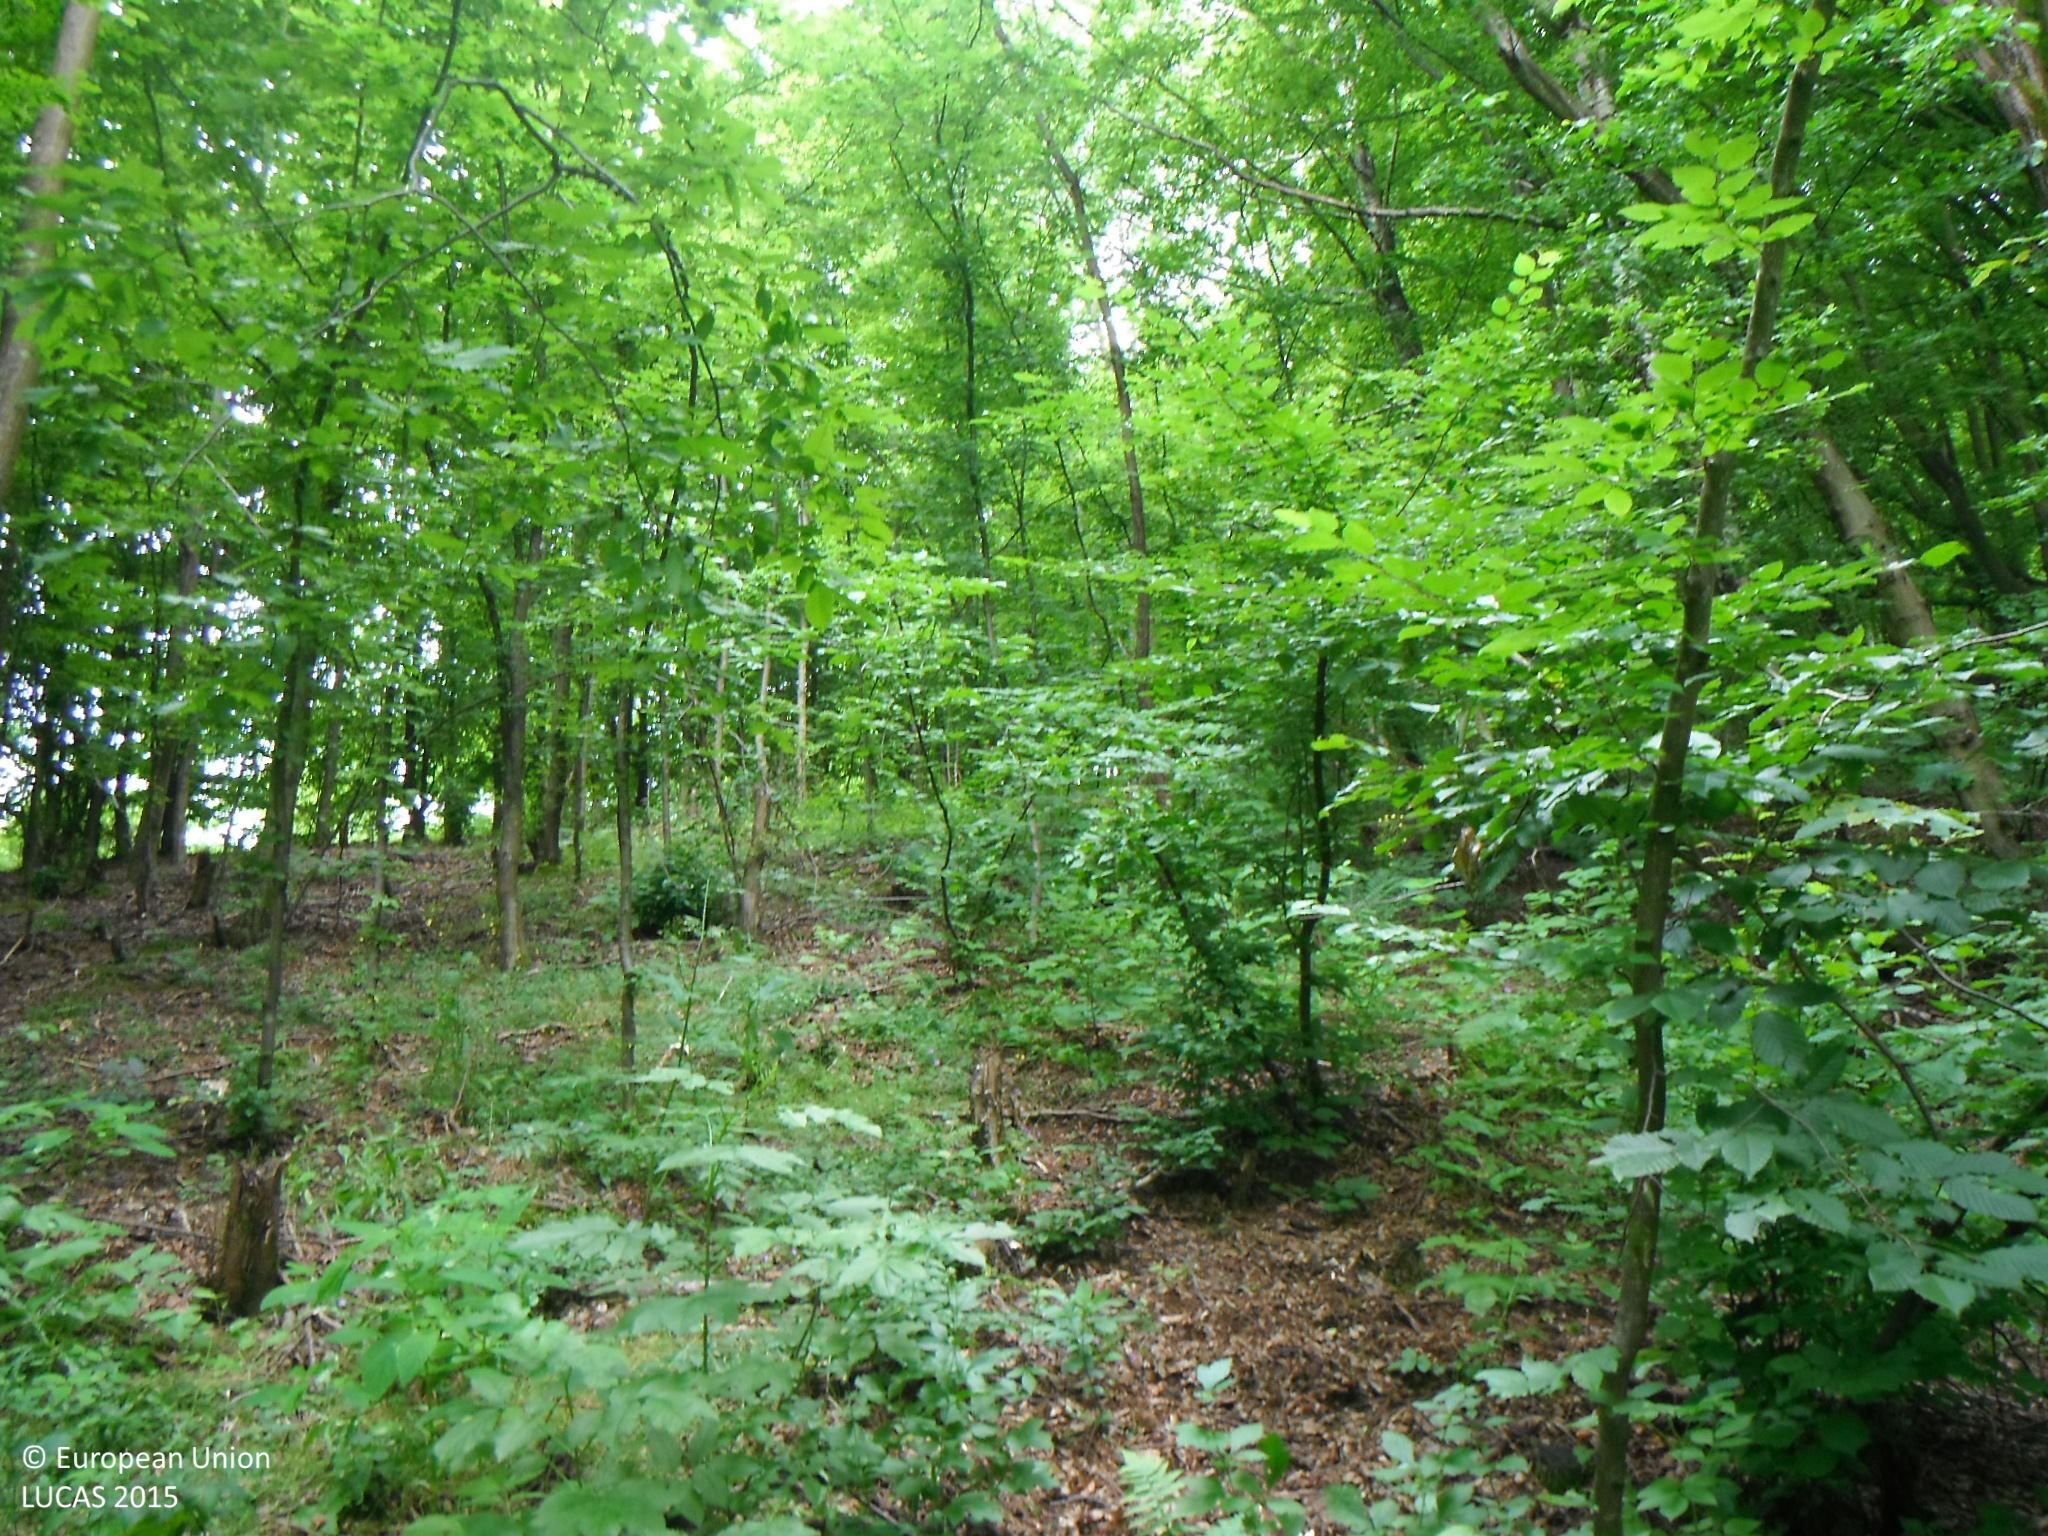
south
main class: Woodland
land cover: Broadleaved woodland
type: mesophytic deciduous forest
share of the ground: > 75 %
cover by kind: broadleaved forest trees 90 %, herbaceous plants 10 %
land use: Forestry
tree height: > 5 m
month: June
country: SK
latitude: 48.6246
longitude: 19.9468
